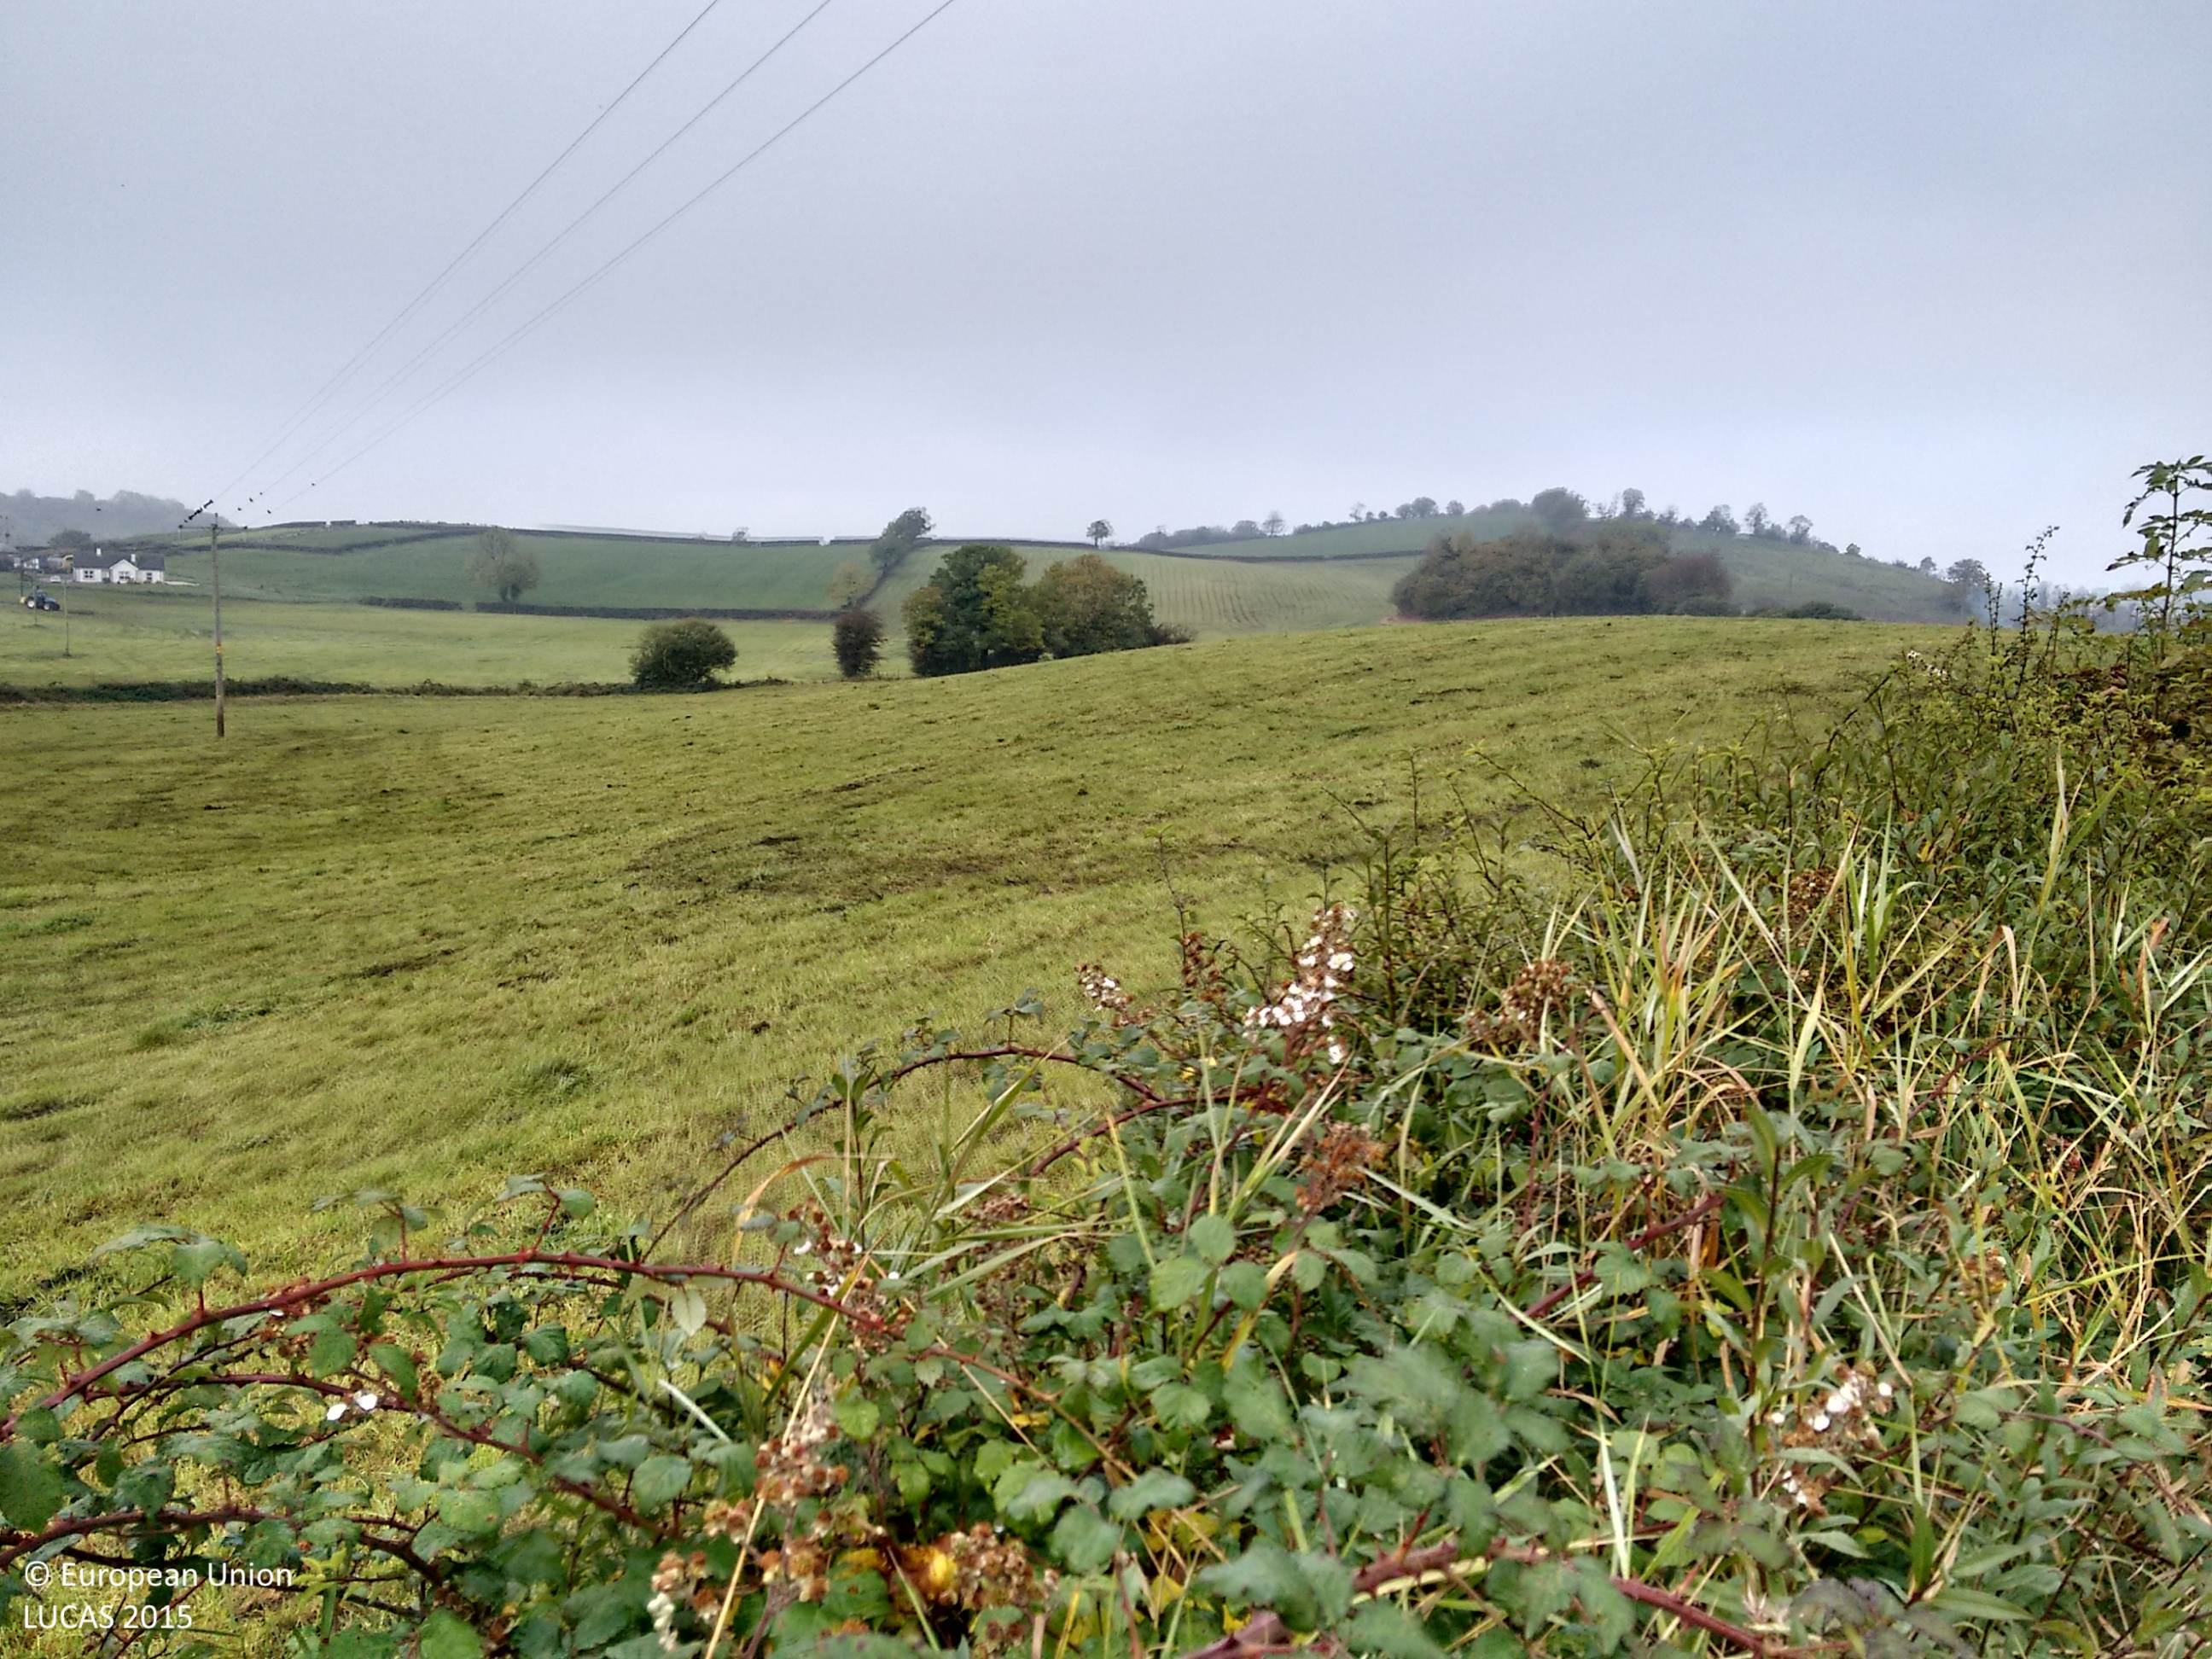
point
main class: Grassland
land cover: Grassland without tree/shrub cover
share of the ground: > 75 %
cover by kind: herbaceous plants 100 %
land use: Agriculture (excluding fallow land and kitchen gardens)
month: October
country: GB
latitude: 54.4438
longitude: -7.8231
